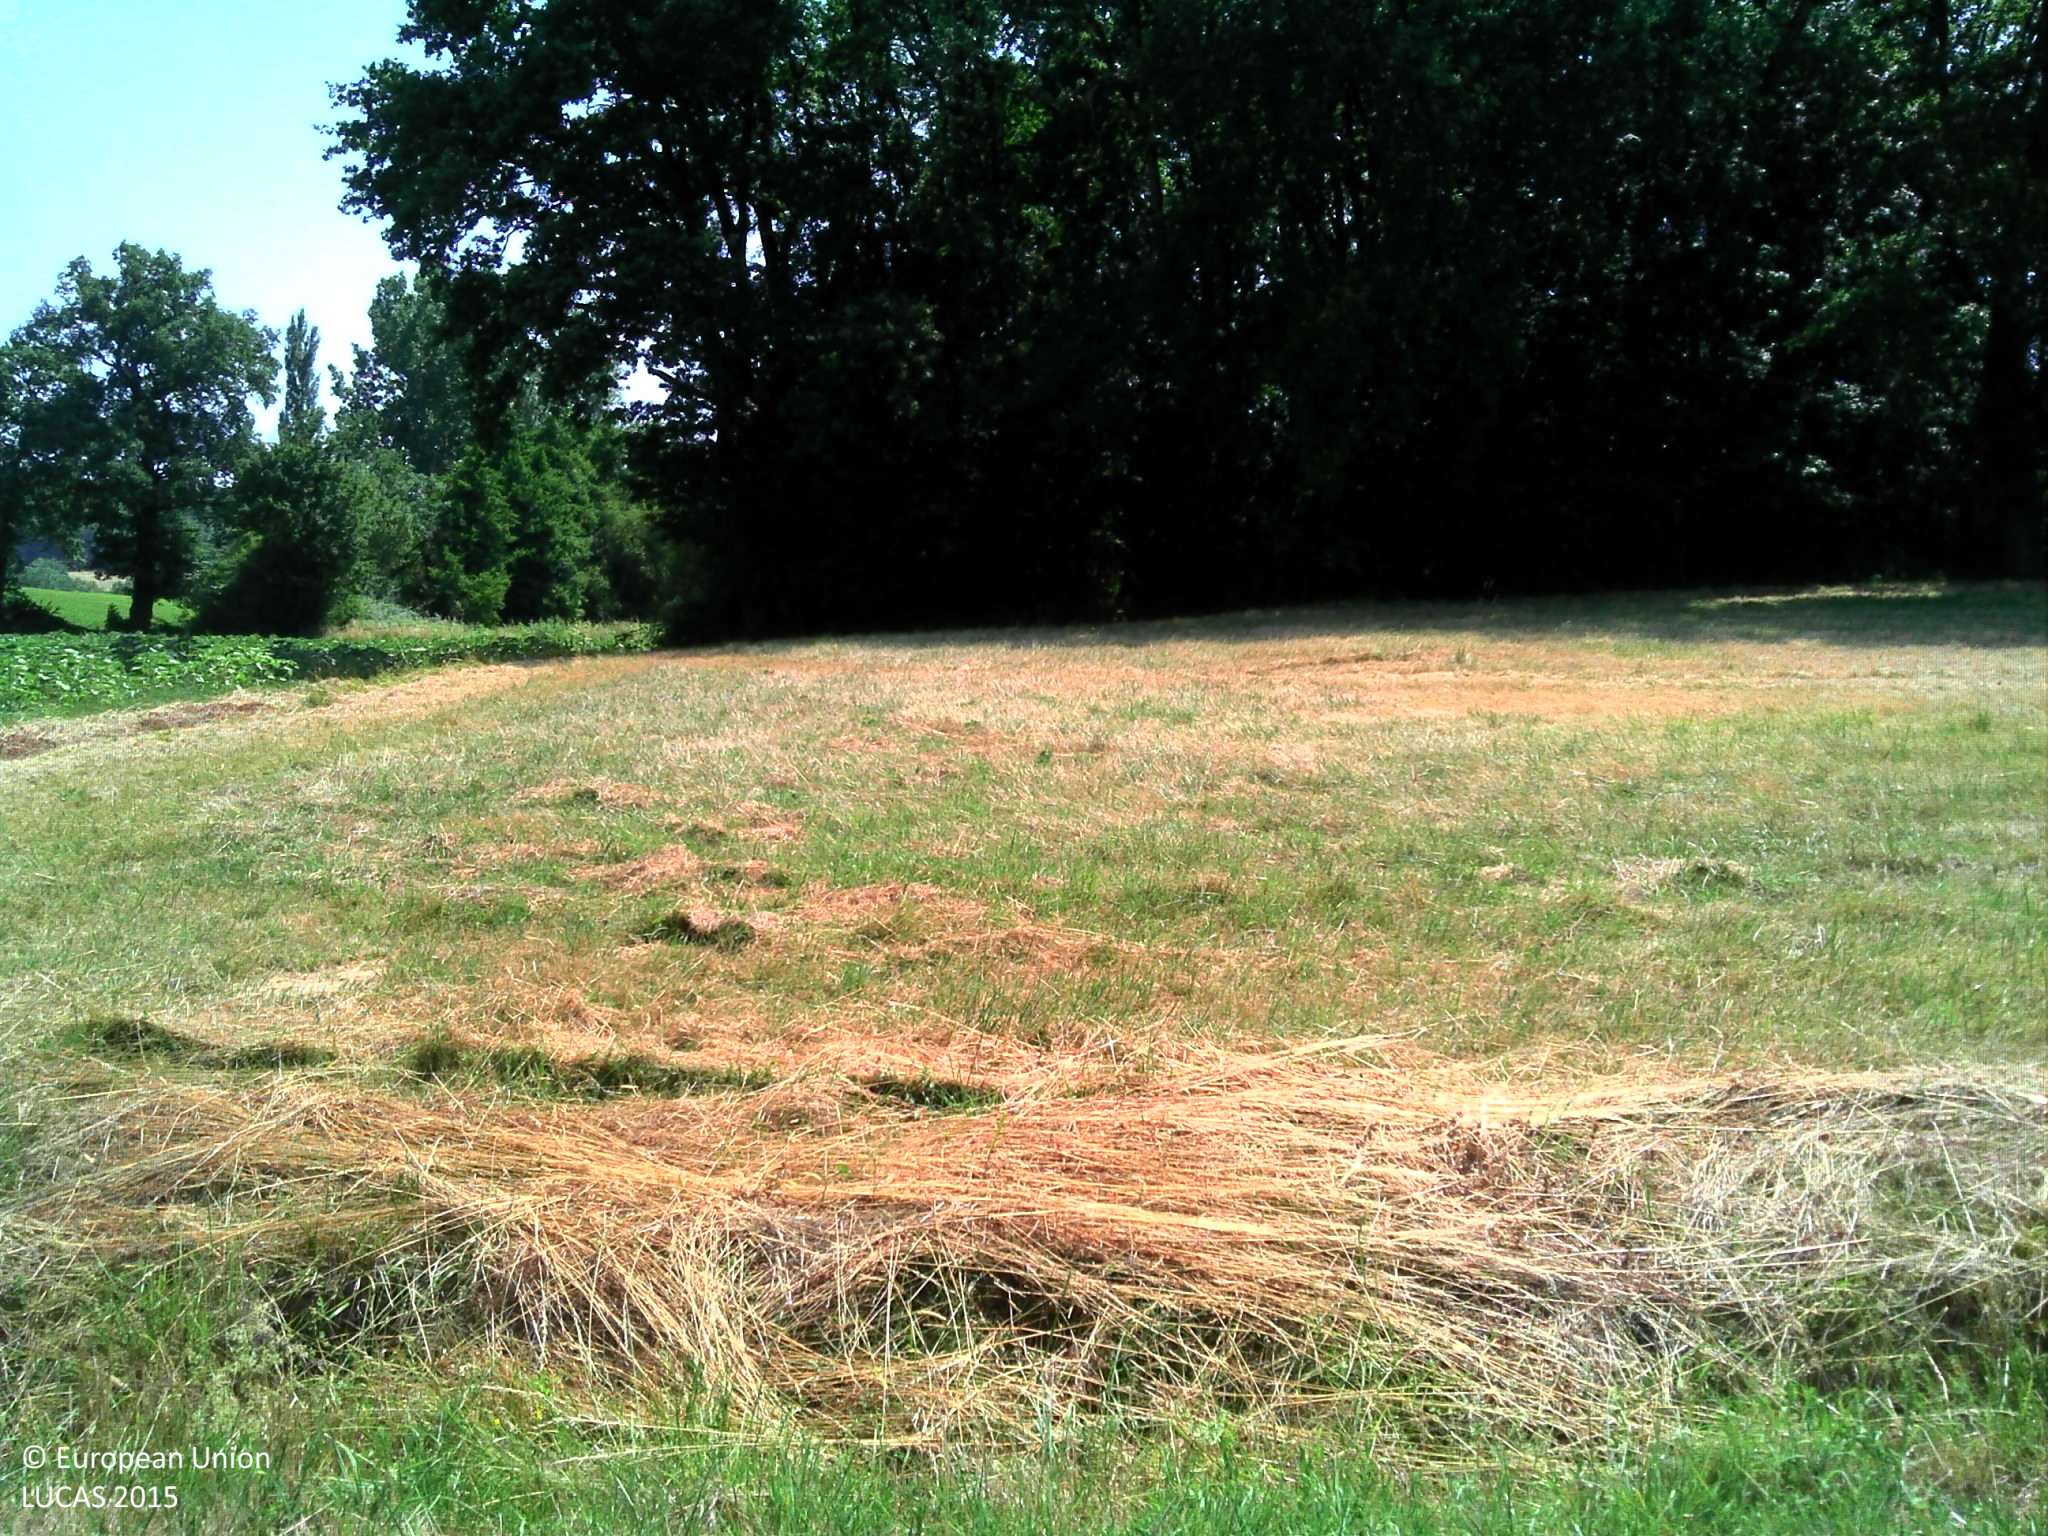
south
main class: Grassland
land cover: Grassland without tree/shrub cover
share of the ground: > 75 %
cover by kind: herbaceous plants 100 %
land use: Agriculture (excluding fallow land and kitchen gardens)
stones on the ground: < 10 %
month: July
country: FR
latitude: 44.4543
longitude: 0.8585
